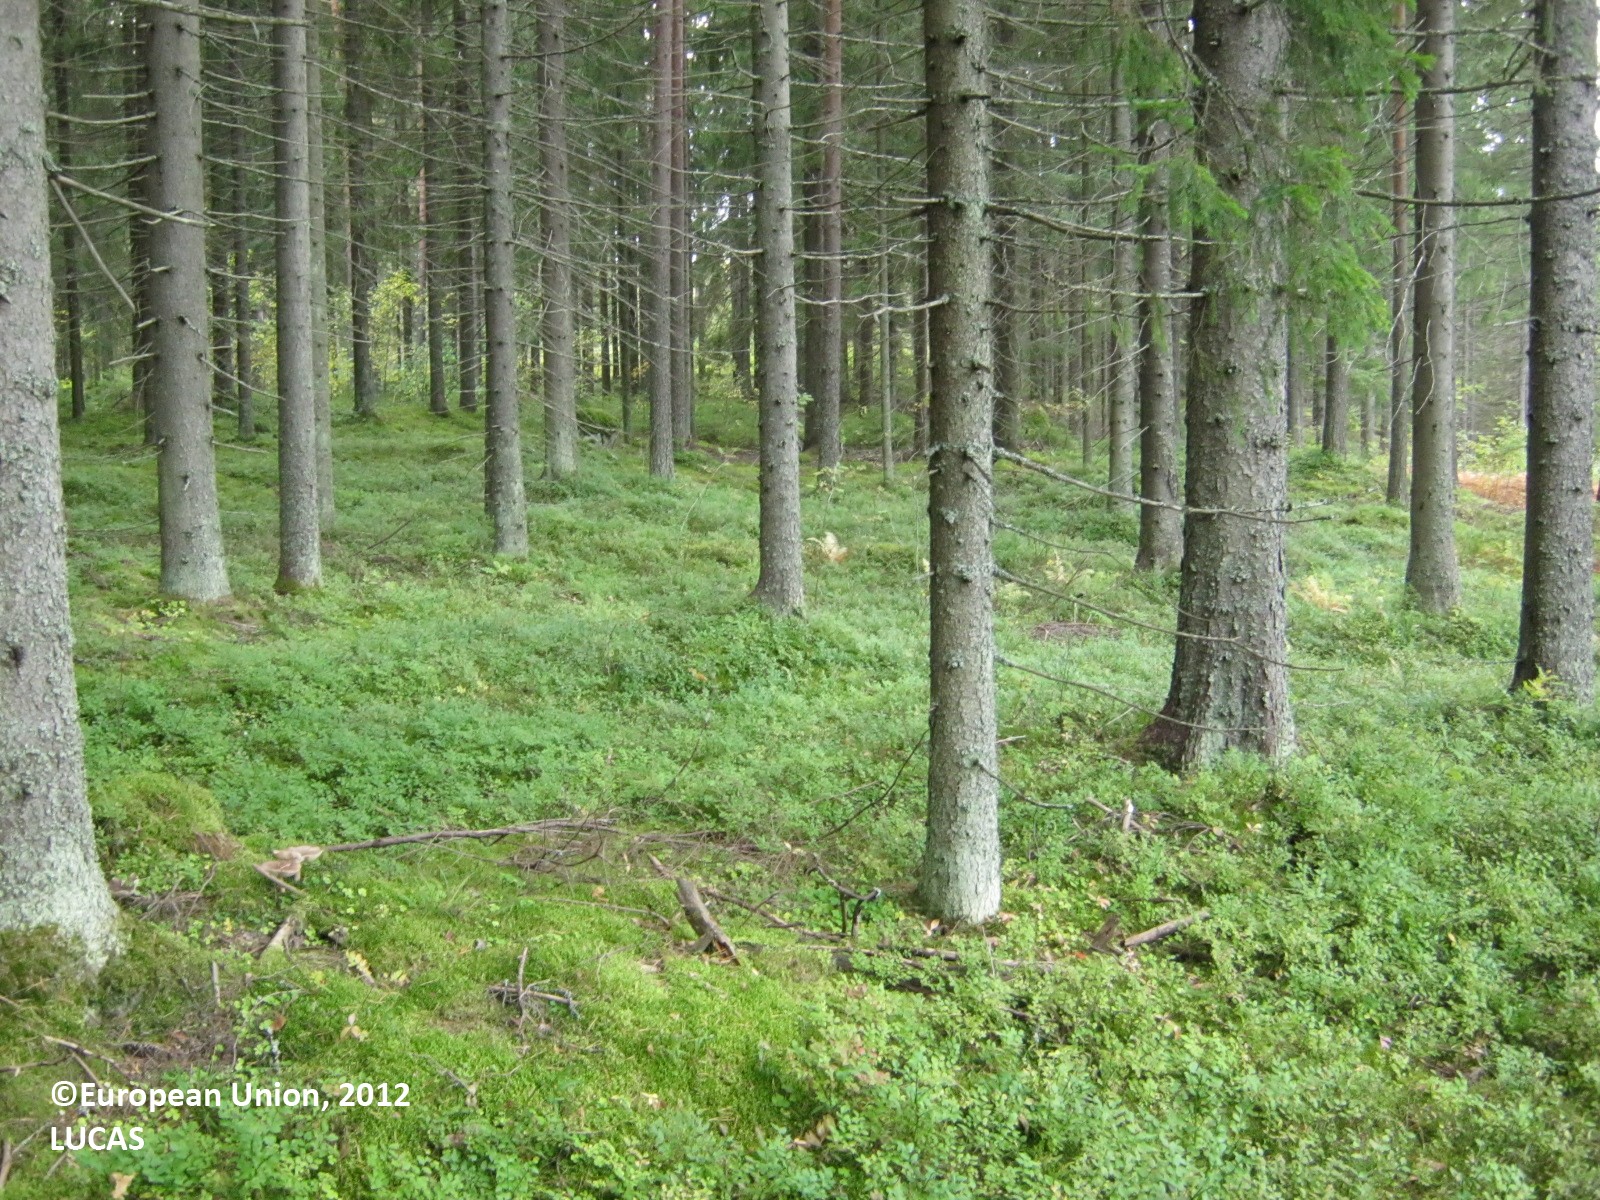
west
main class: Woodland
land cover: Spruce dominated coniferous woodland
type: boreal forest
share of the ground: > 75 %
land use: Forestry
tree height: > 5 m
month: September
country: FI
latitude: 60.7712
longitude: 27.8385
